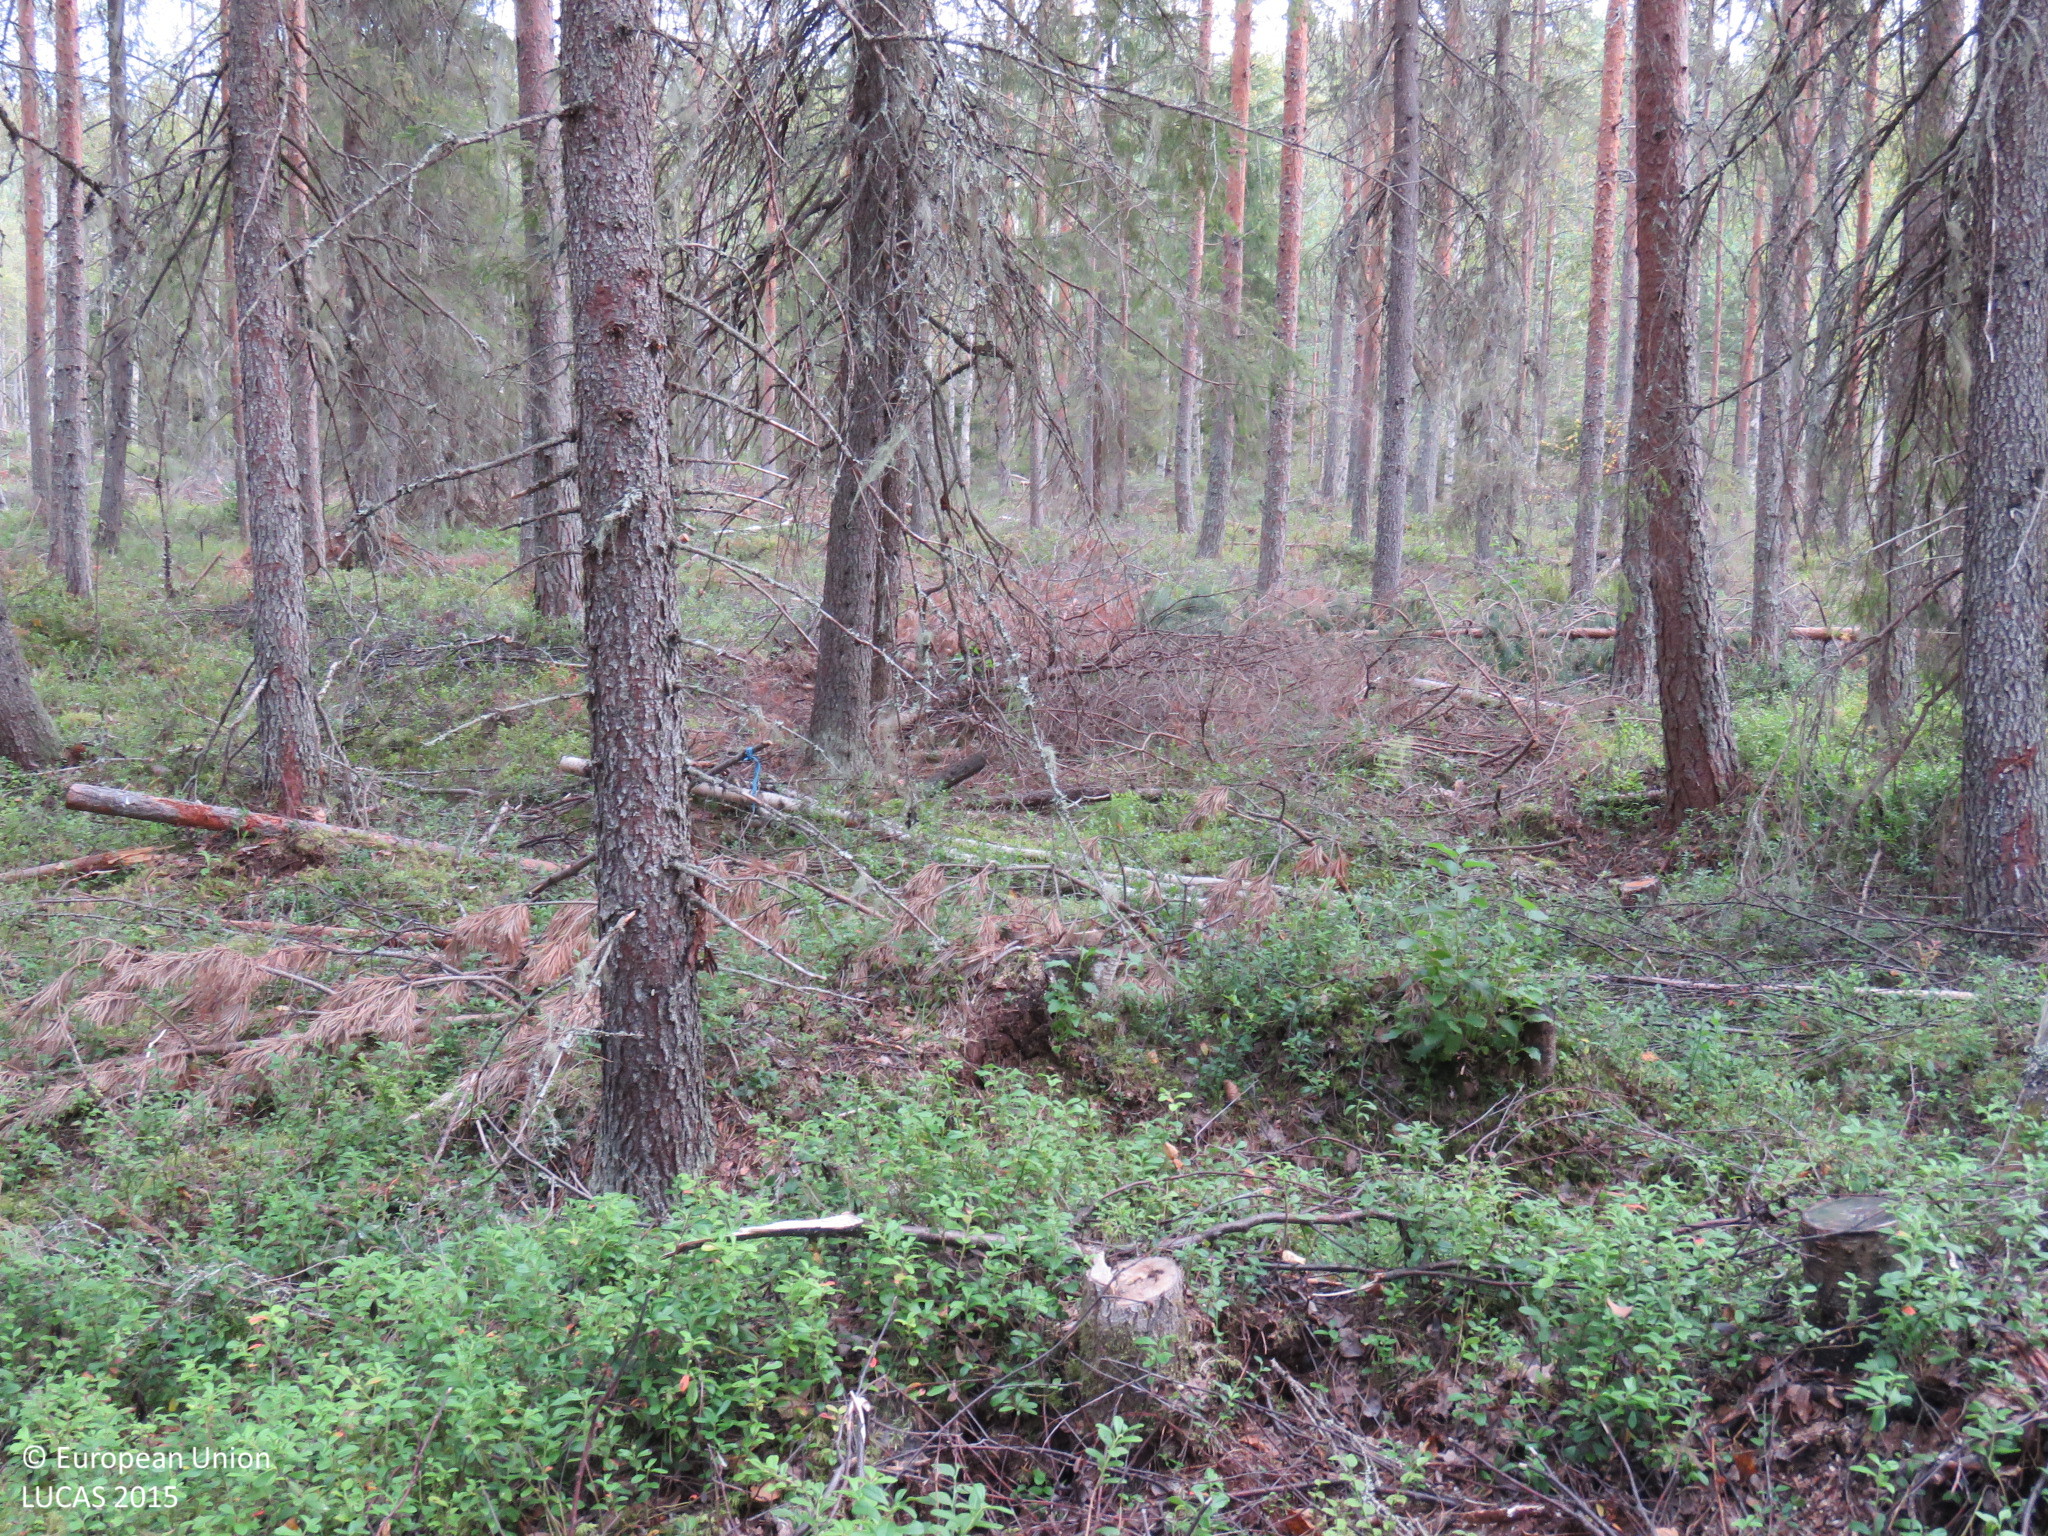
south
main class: Woodland
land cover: Other coniferous woodland
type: boreal forest
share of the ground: > 75 %
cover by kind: coniferous forest trees 60 %, broadleaved forest trees 15 %, shrubs 15 %, lichens and mosses 5 %
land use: Forestry
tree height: > 5 m
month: August
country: FI
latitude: 65.0556
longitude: 26.2298
